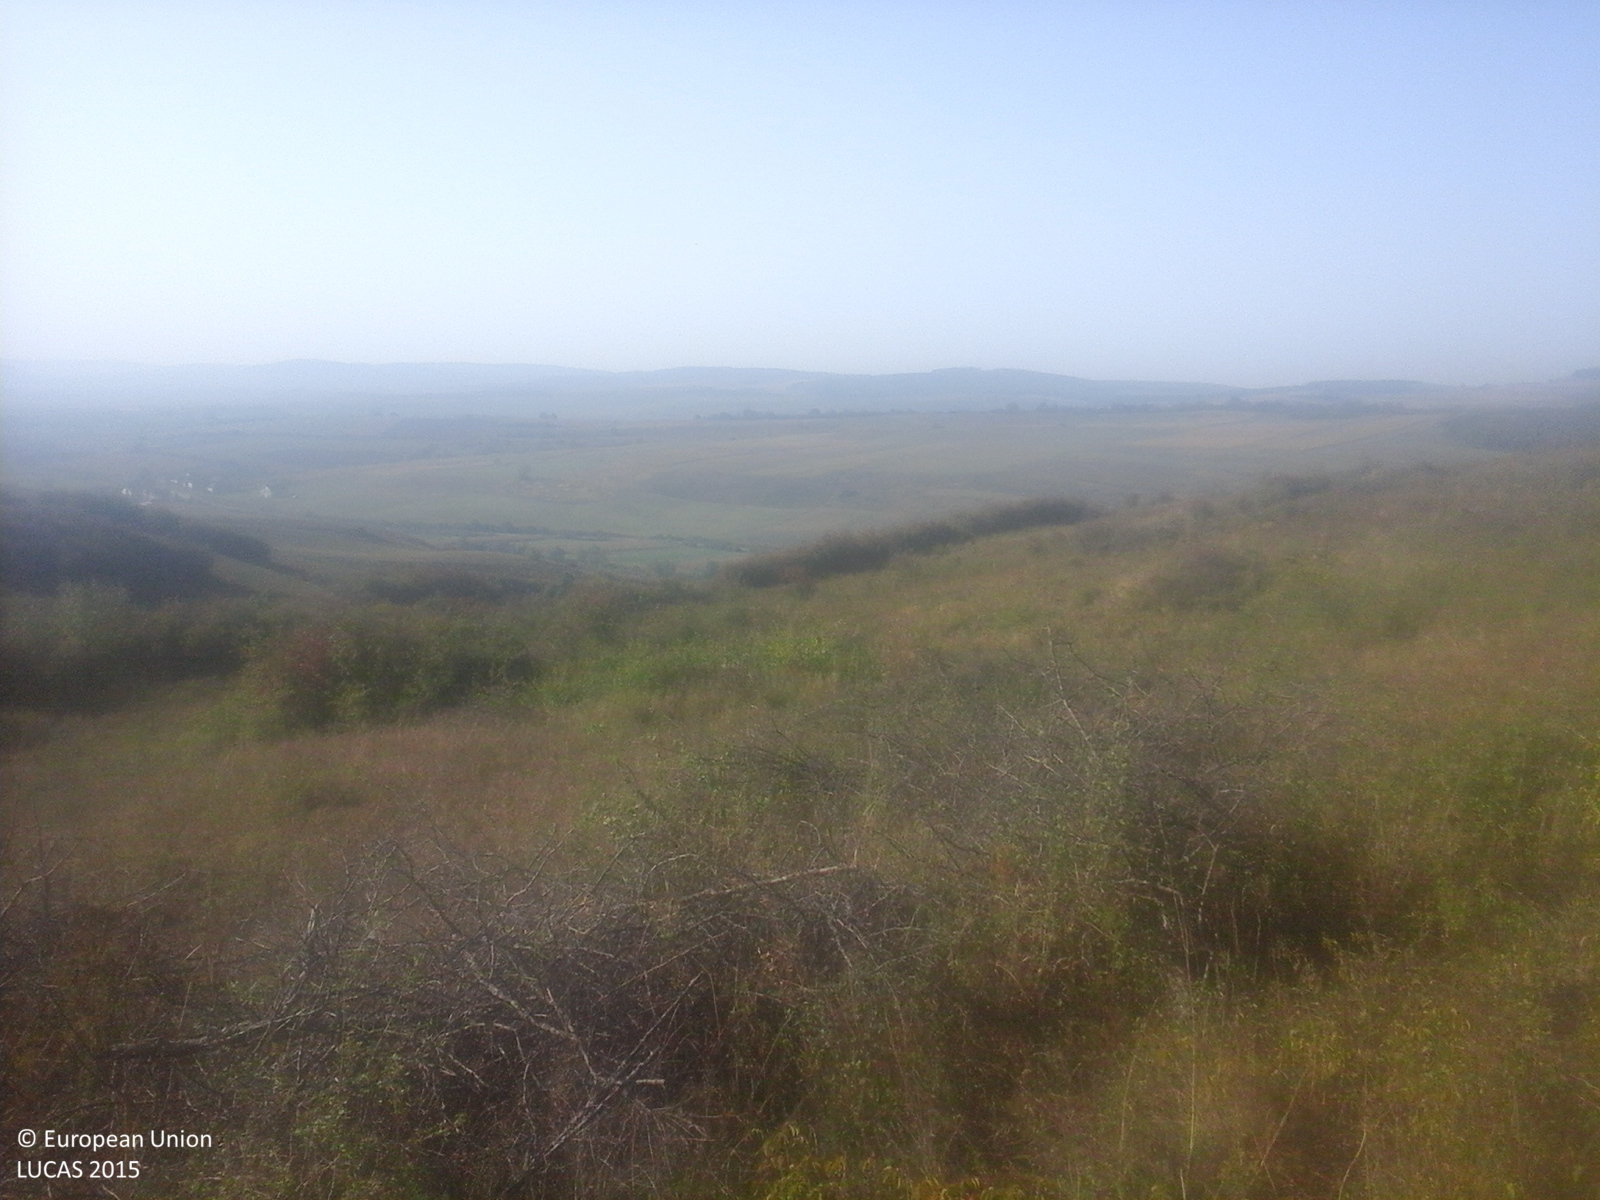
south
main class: Grassland
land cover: Grassland with sparse tree/shrub cover
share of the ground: > 75 %
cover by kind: herbaceous plants 85 %, shrubs 10 %, broadleaved forest trees 5 %
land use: Agriculture (excluding fallow land and kitchen gardens)
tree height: < 5 m
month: September
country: RO
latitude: 47.0349
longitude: 24.2584
